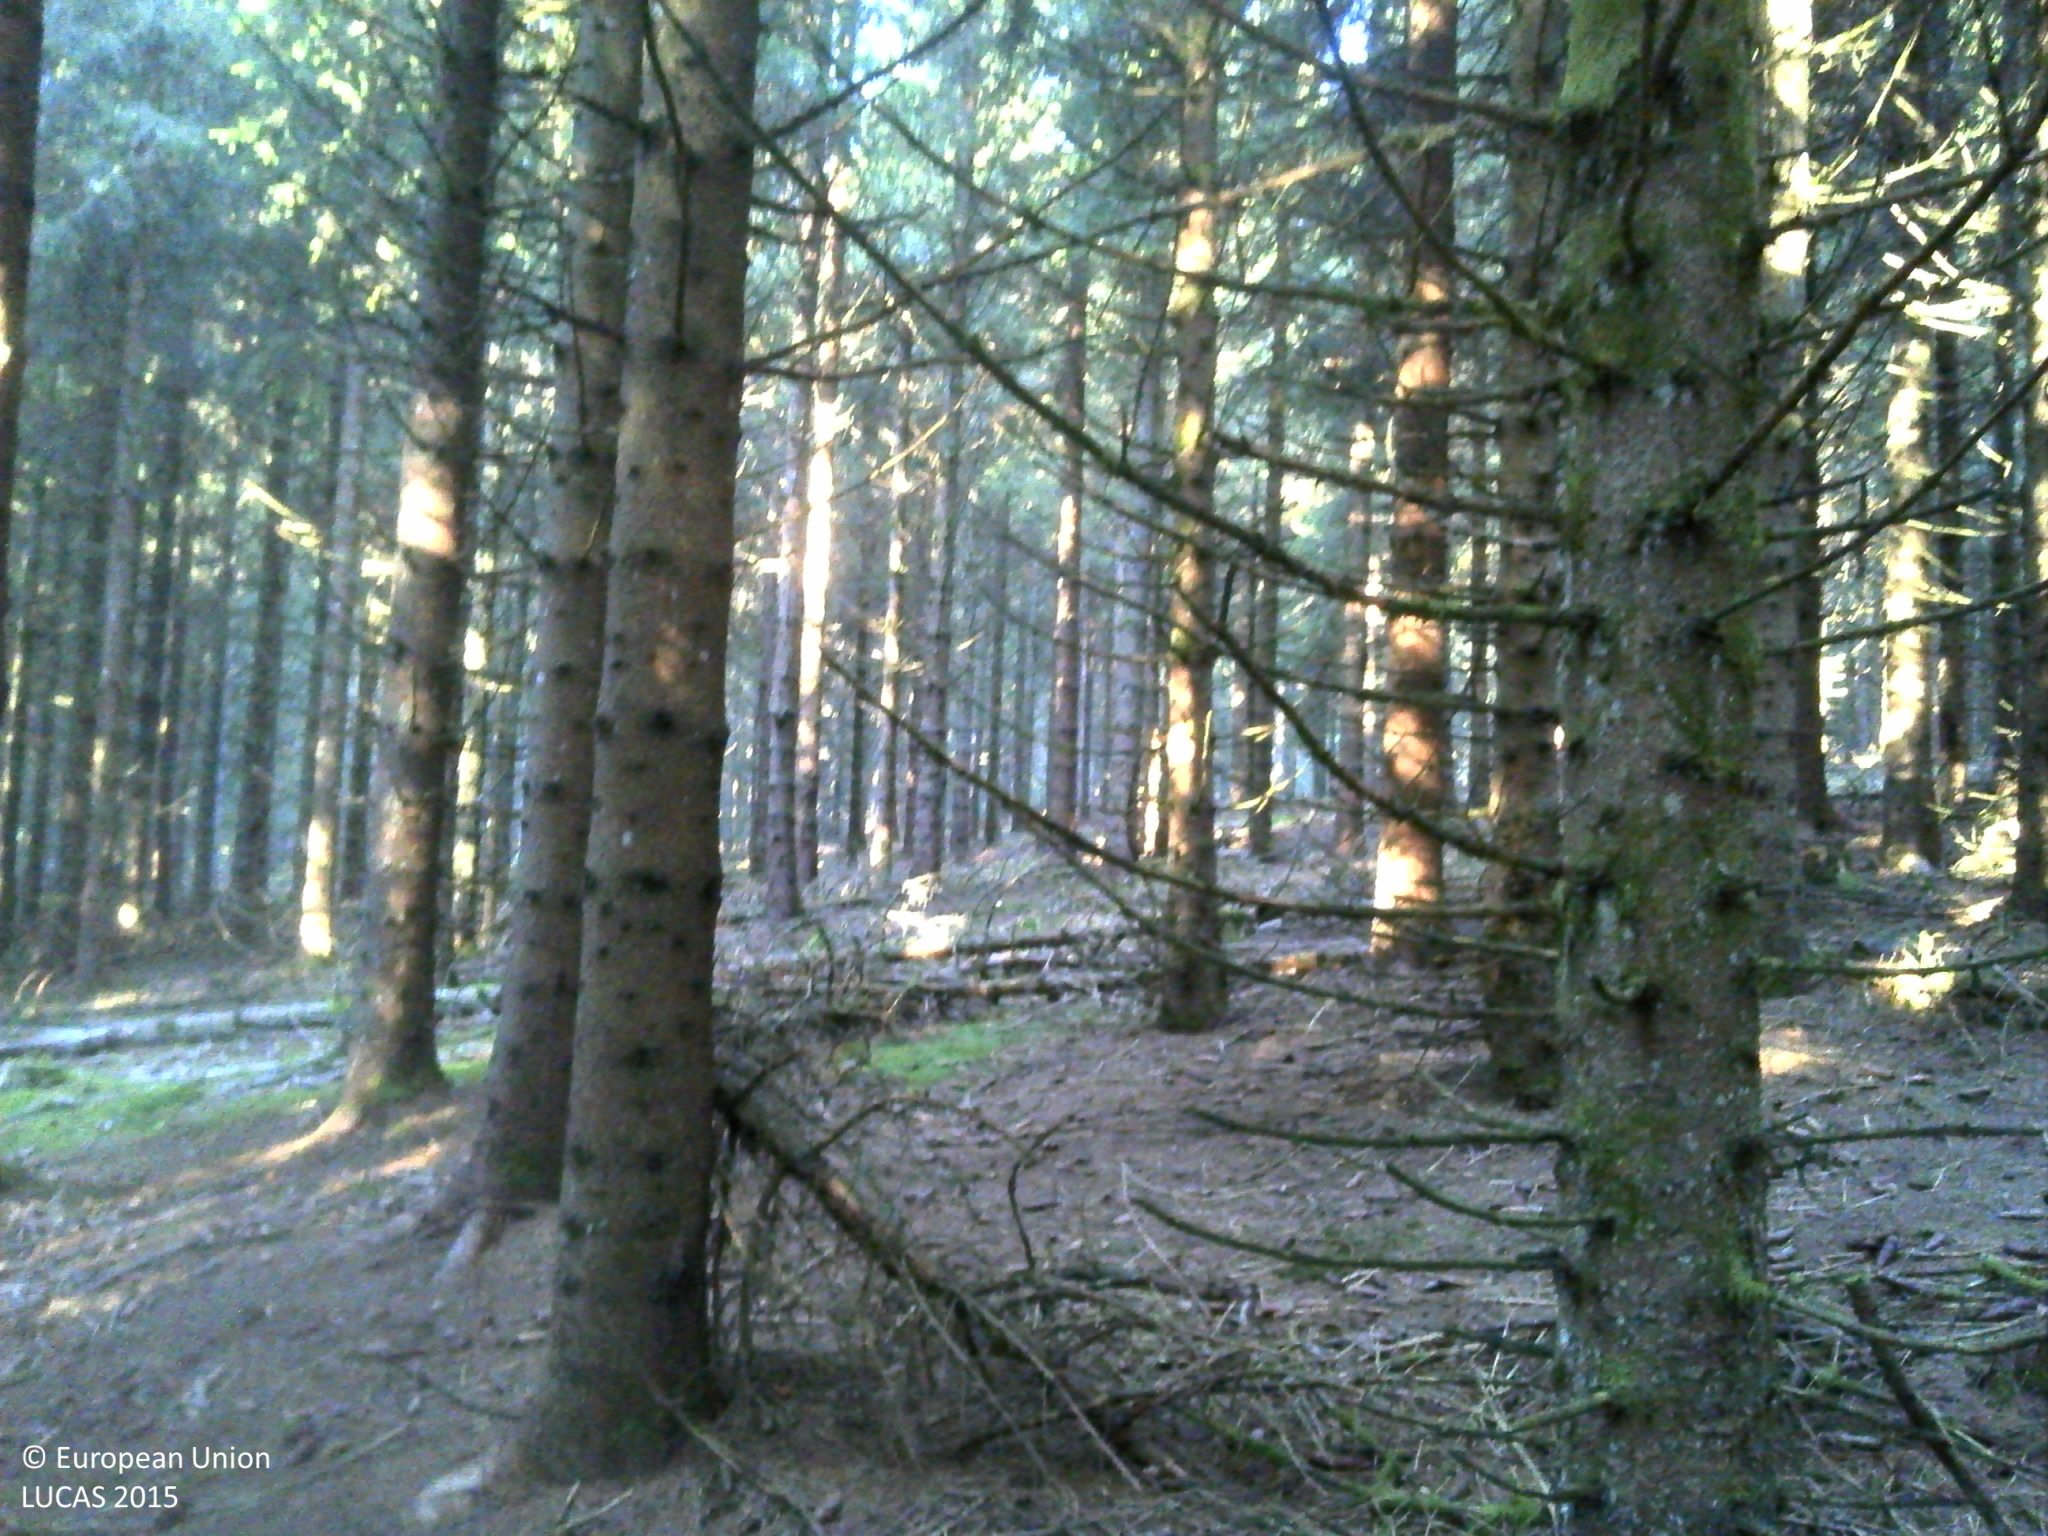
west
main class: Woodland
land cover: Spruce dominated coniferous woodland
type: exotic forest
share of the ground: > 75 %
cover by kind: coniferous forest trees 90 %, lichens and mosses 5 %, unconsolidated bare surface 5 %
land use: Forestry
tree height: > 5 m
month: October
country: FR
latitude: 45.4822
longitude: 2.8996
